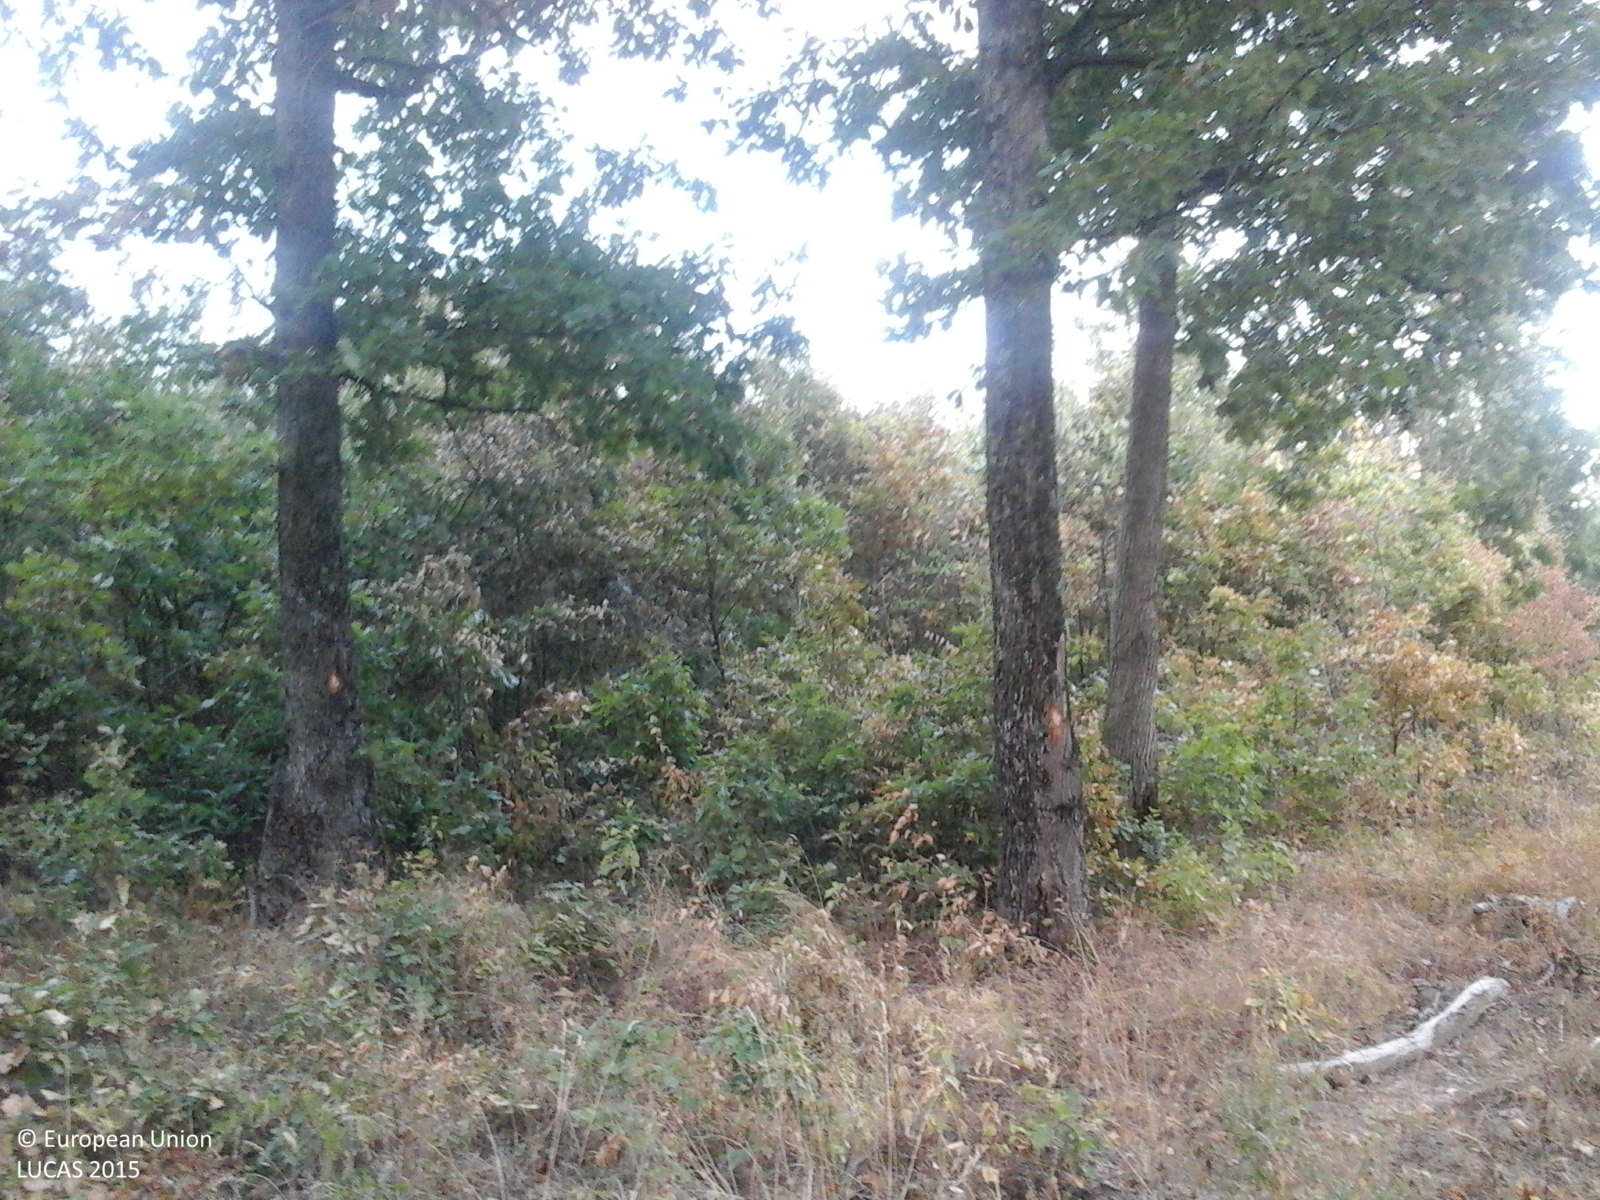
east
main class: Woodland
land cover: Broadleaved woodland
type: acidophilous oak and oak-birch forest
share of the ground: > 75 %
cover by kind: broadleaved forest trees 100 %
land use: Forestry
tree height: > 5 m
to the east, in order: Broadleaved woodland
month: September
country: RO
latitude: 47.6529
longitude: 23.1289
